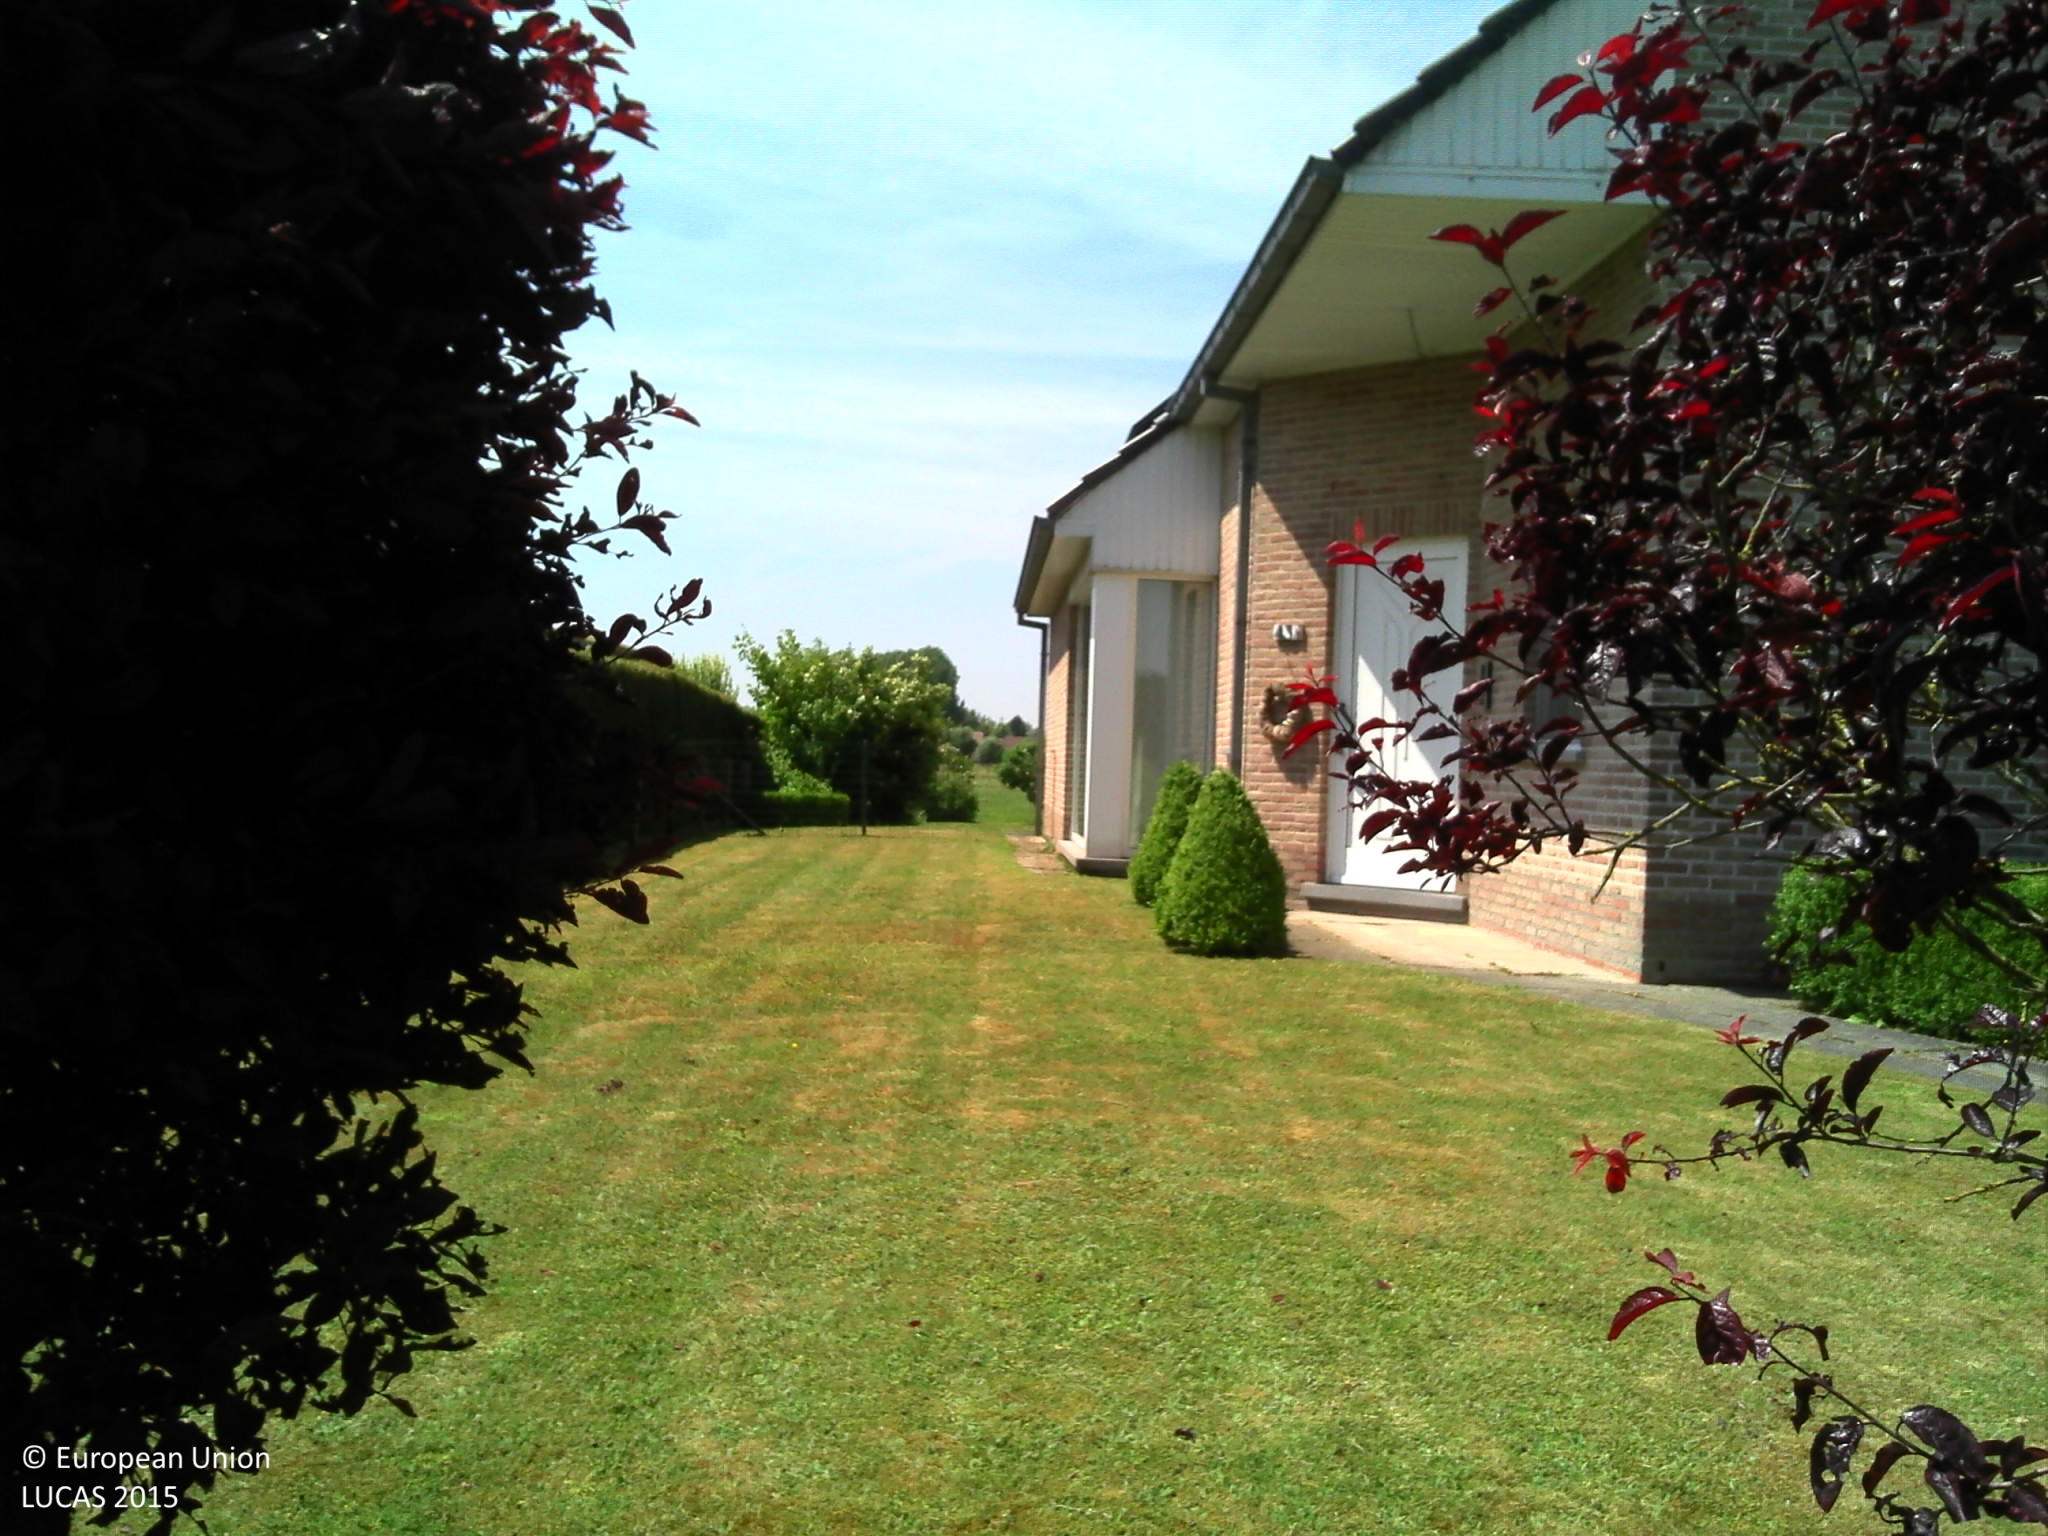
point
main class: Grassland
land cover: Grassland with sparse tree/shrub cover
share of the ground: > 75 %
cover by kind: herbaceous plants 95 %, broadleaved forest trees 5 %
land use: Residential
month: June
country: BE
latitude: 51.0592
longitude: 4.1018
